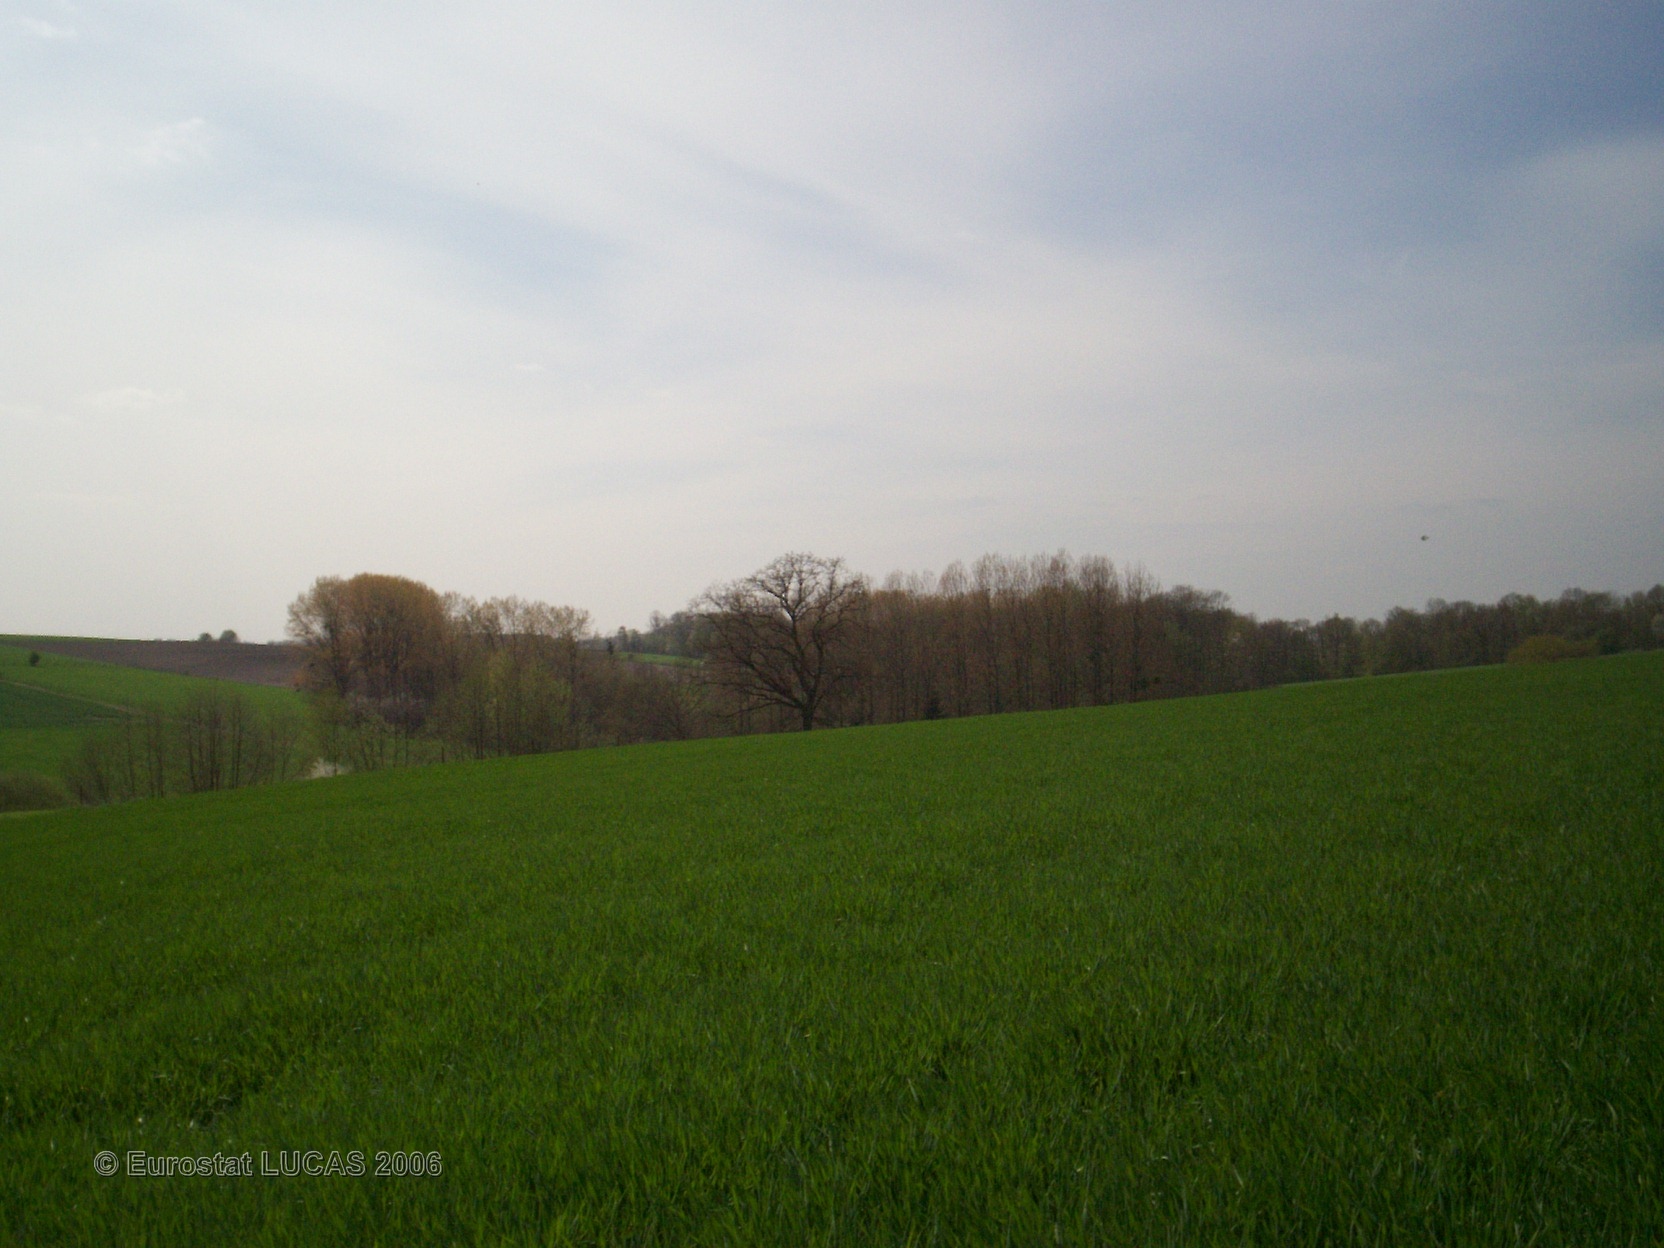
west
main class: Cropland
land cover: Common wheat
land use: Agriculture (excluding fallow land and kitchen gardens)
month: April
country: FR
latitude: 49.7376
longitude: 4.3483
